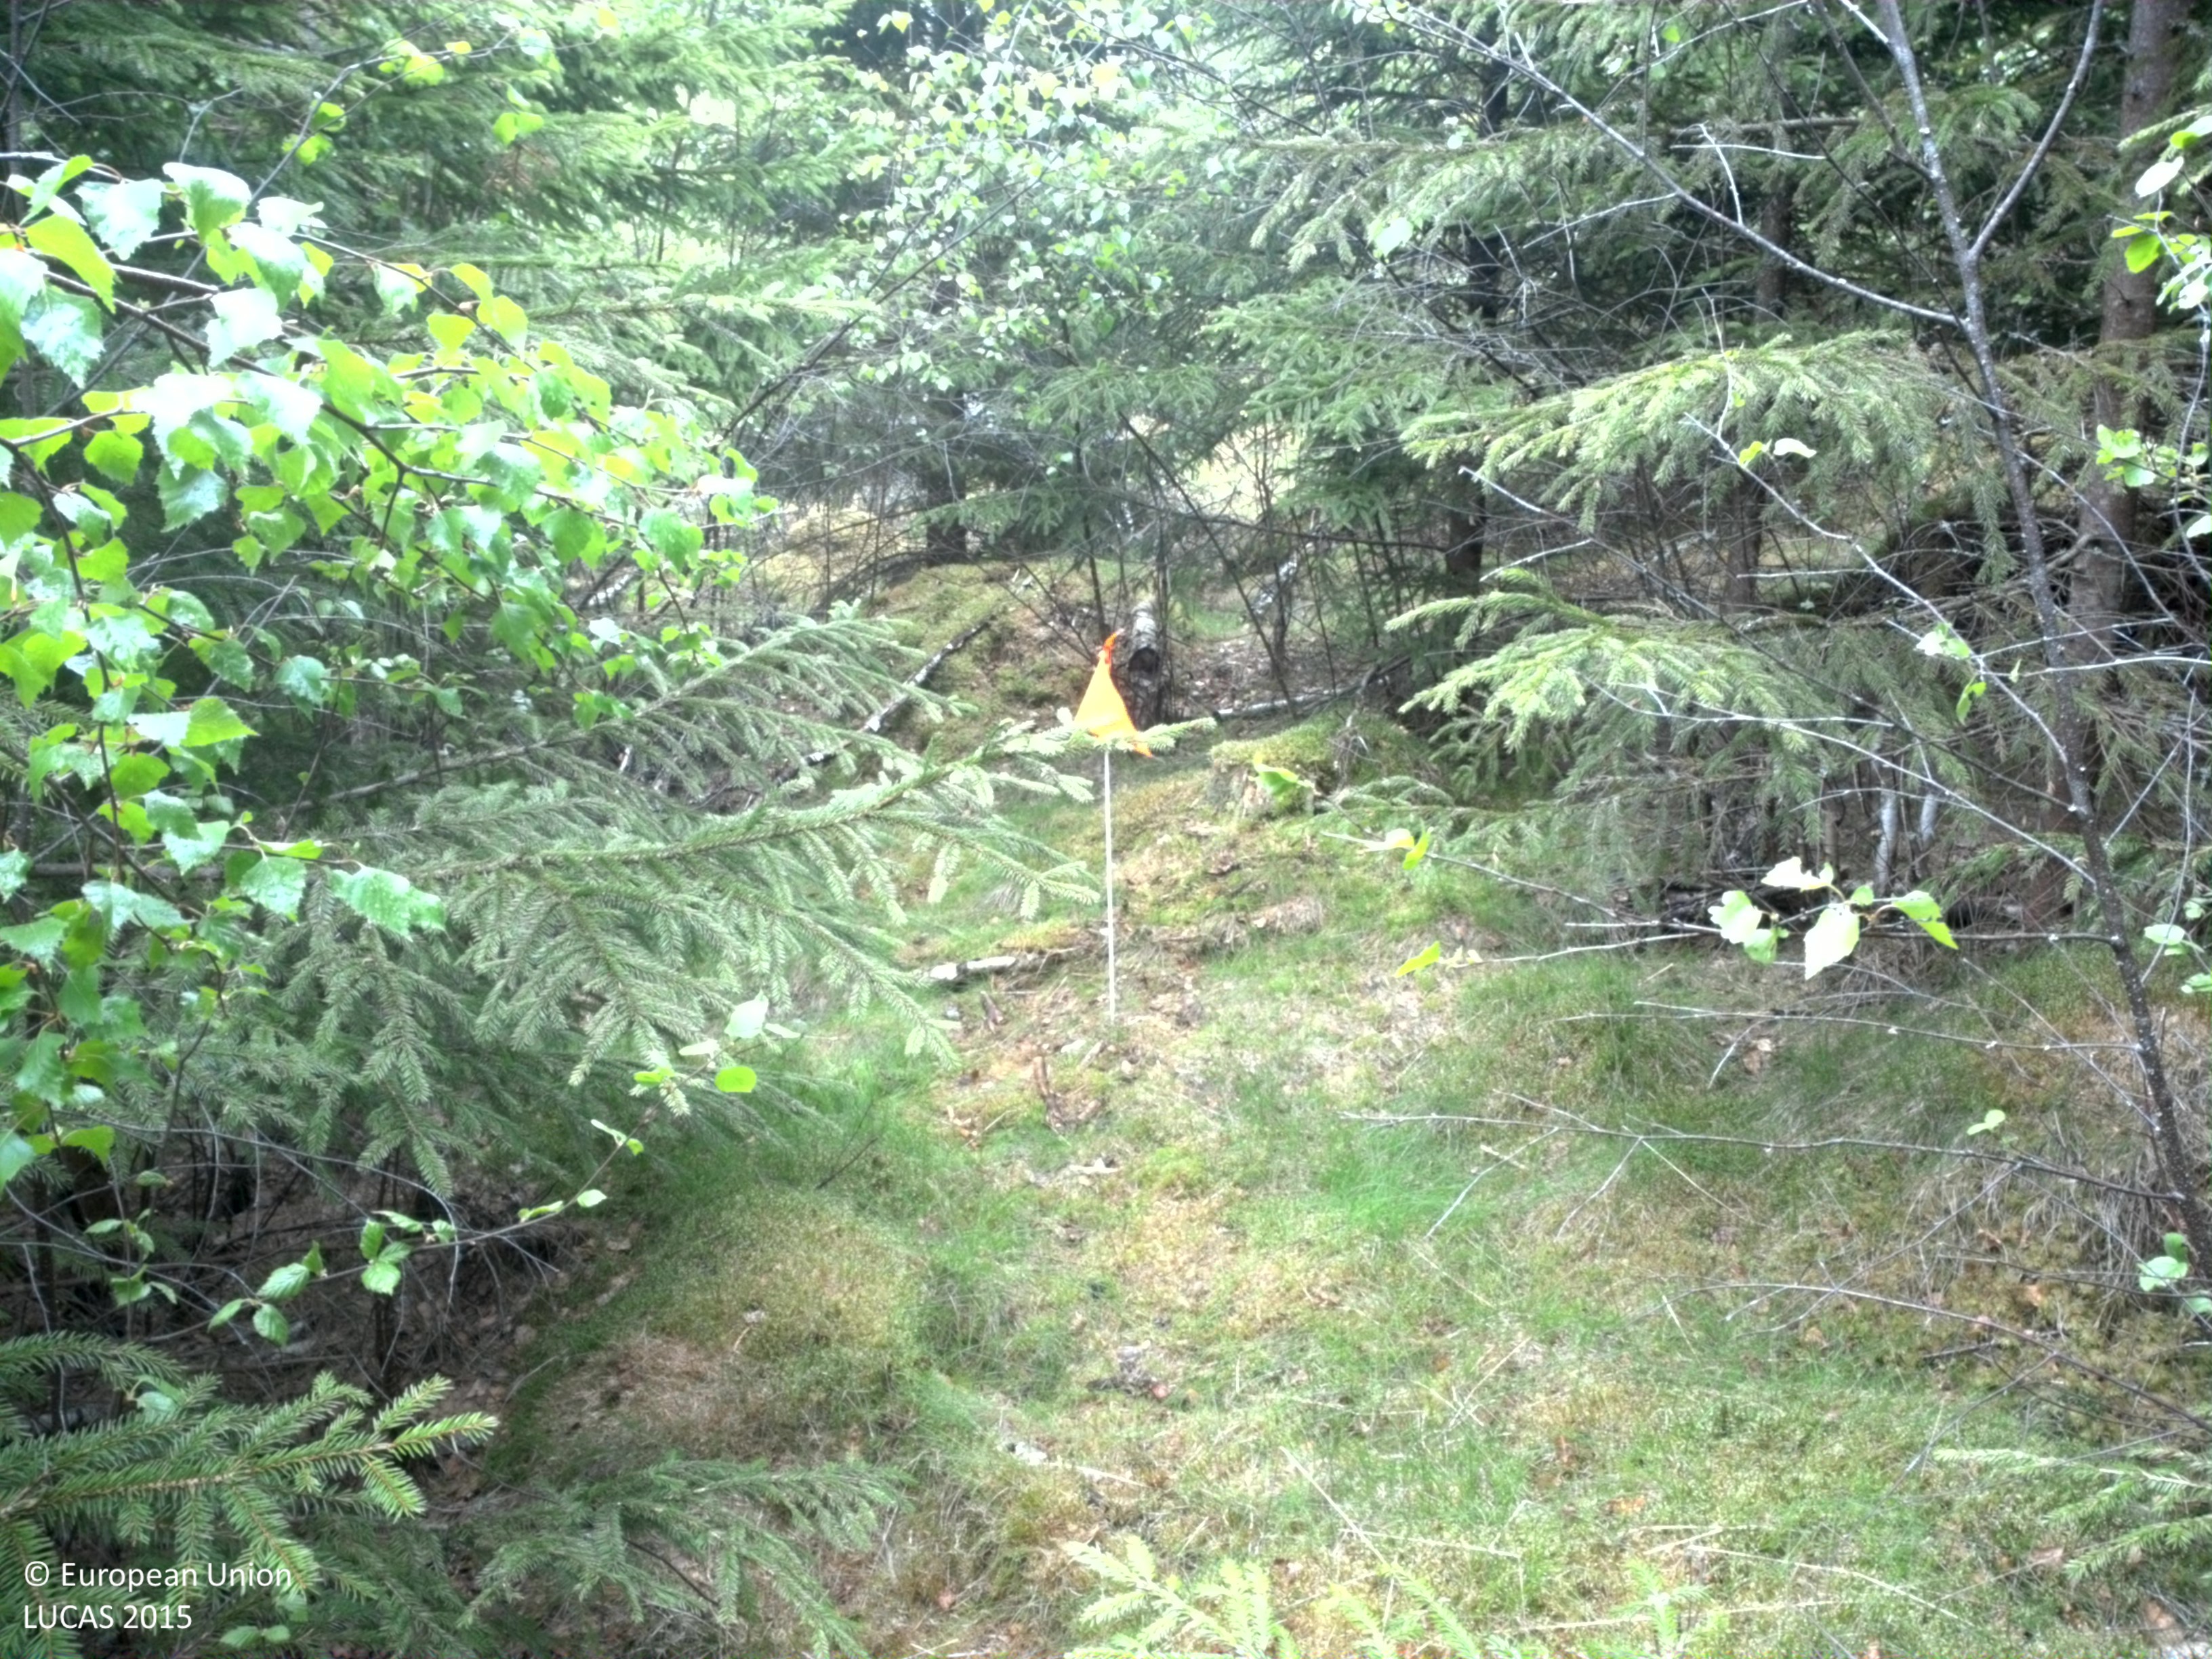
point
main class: Woodland
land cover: Spruce dominated mixed woodland
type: boreal forest
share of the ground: > 75 %
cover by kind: coniferous forest trees 60 %, broadleaved forest trees 20 %, herbaceous plants 10 %, lichens and mosses 10 %
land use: Forestry
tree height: < 5 m
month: May
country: SE
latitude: 56.5898
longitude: 15.1276
